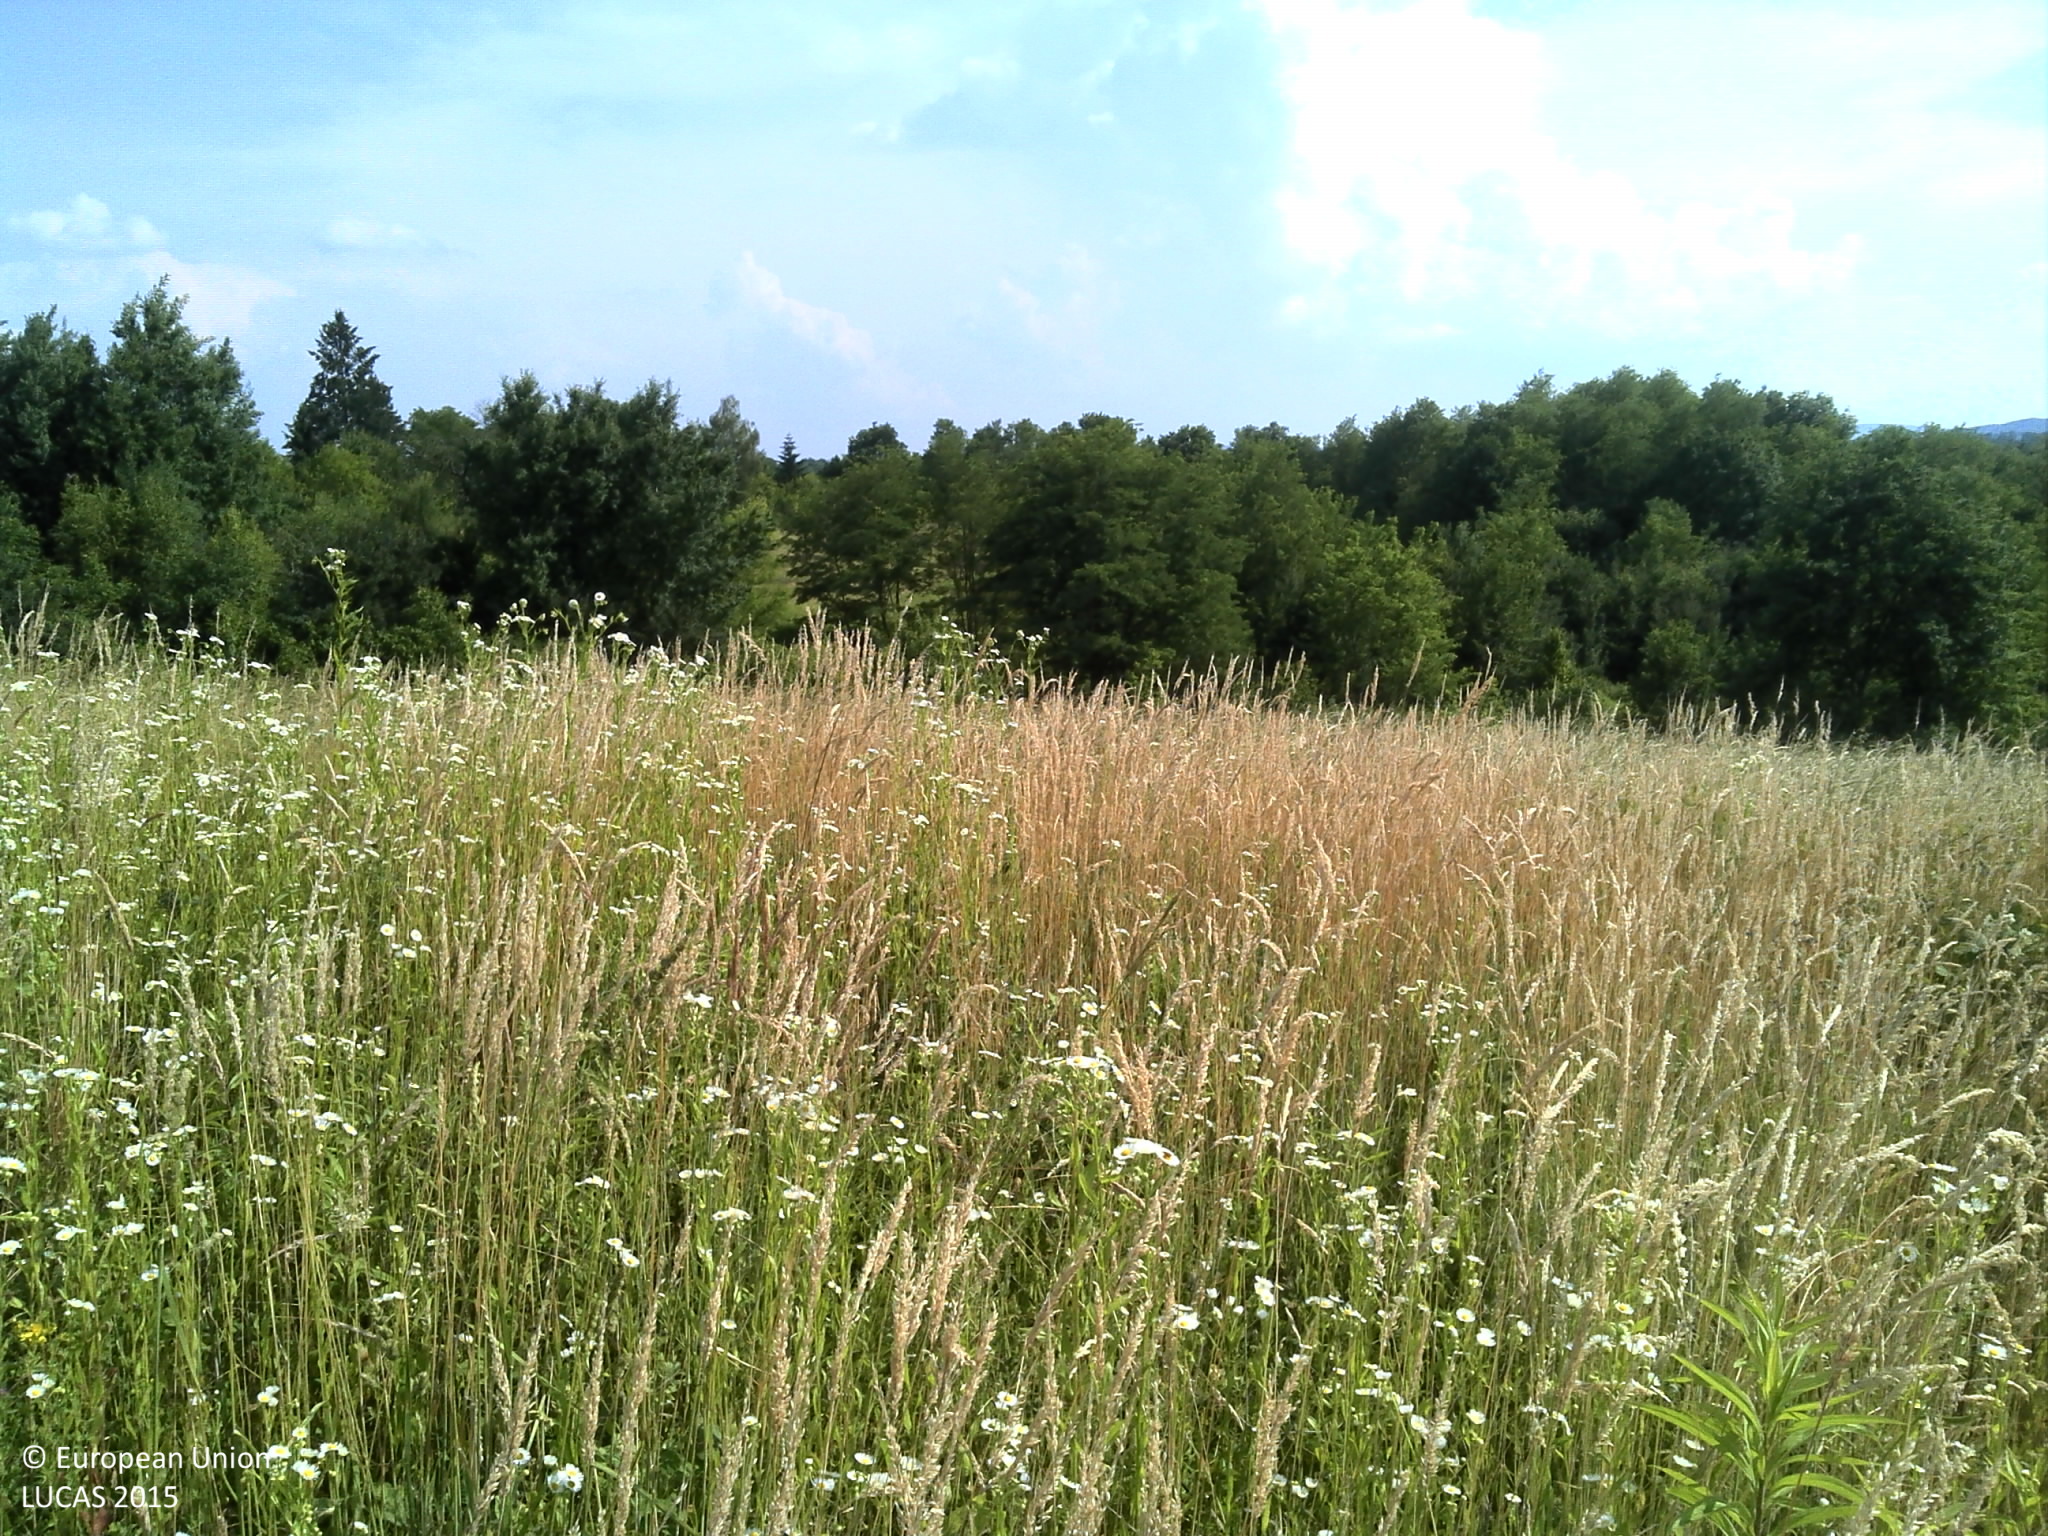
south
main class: Grassland
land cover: Spontaneously vegetated surfaces
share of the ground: > 75 %
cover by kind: herbaceous plants 100 %
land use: Semi-natural and natural areas not in use
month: June
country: HR
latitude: 45.4609
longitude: 17.1490
